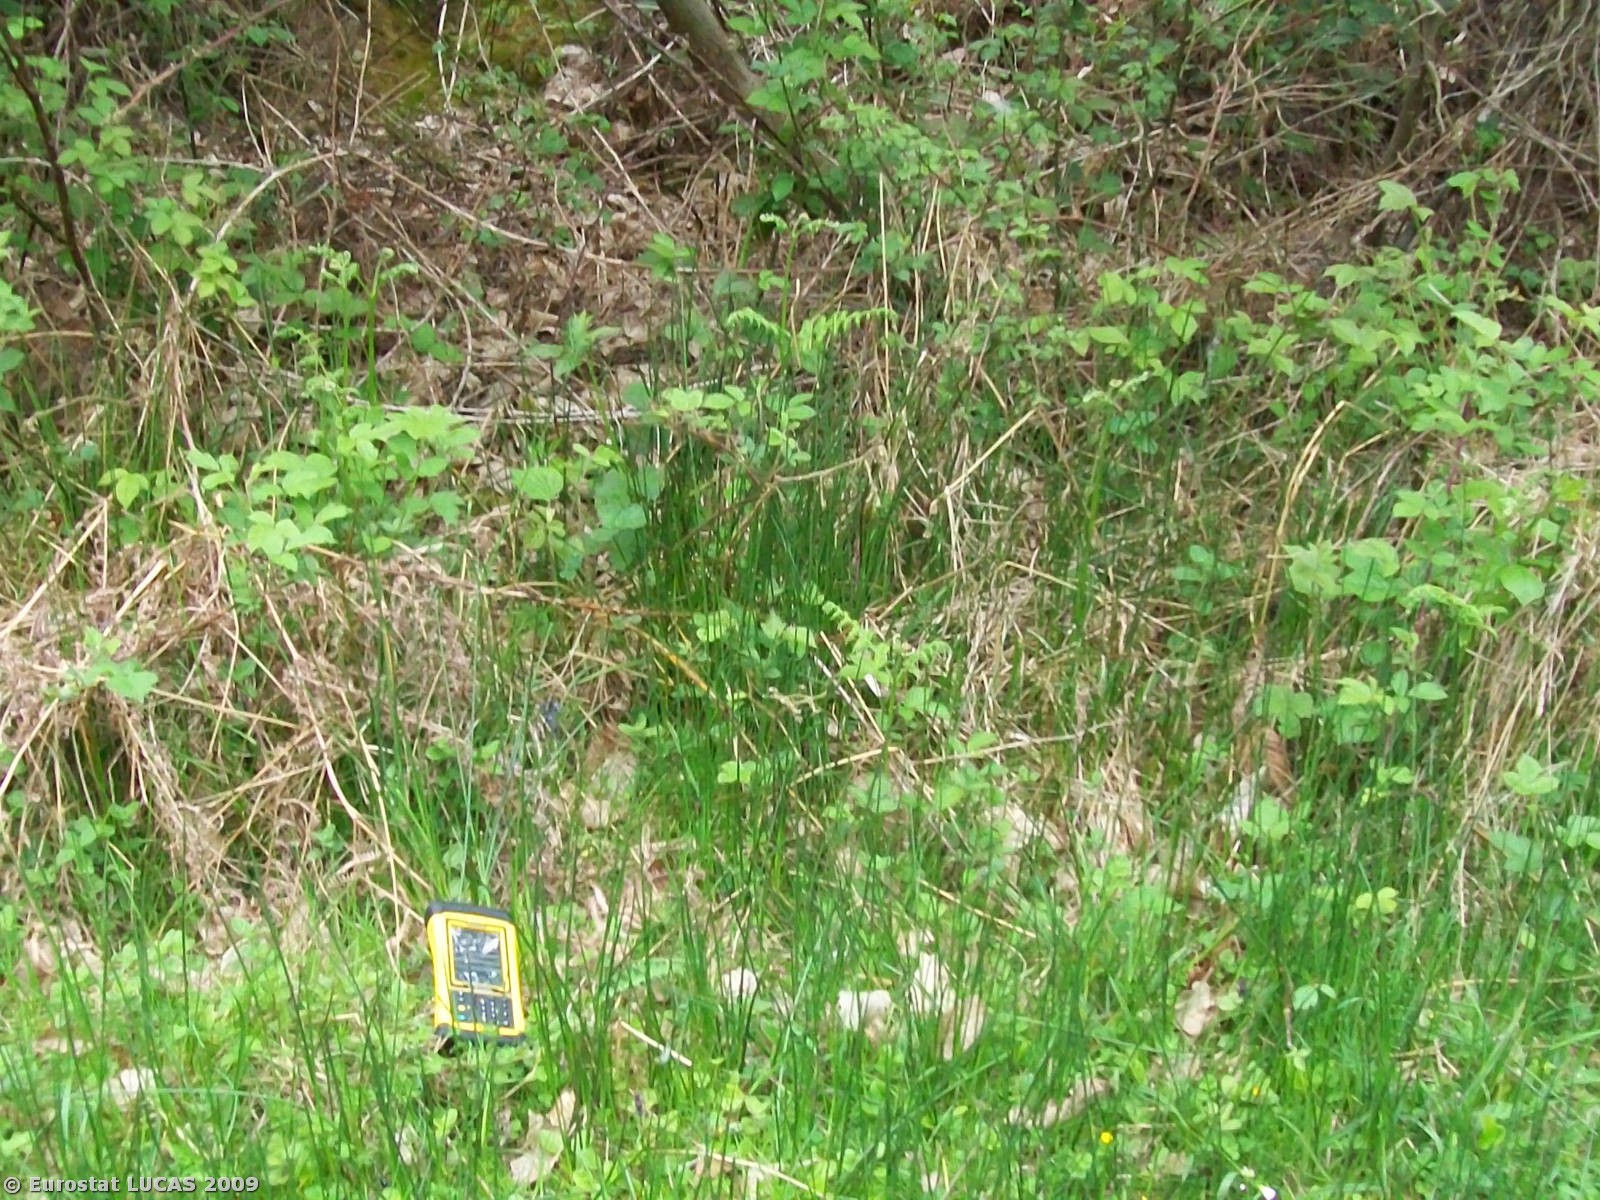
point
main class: Woodland
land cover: Mixed woodland
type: mesophytic deciduous forest
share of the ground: > 75 %
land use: Forestry
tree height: > 5 m
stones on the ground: < 10 %
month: May
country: GB
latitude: 51.1125
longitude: 0.3286
